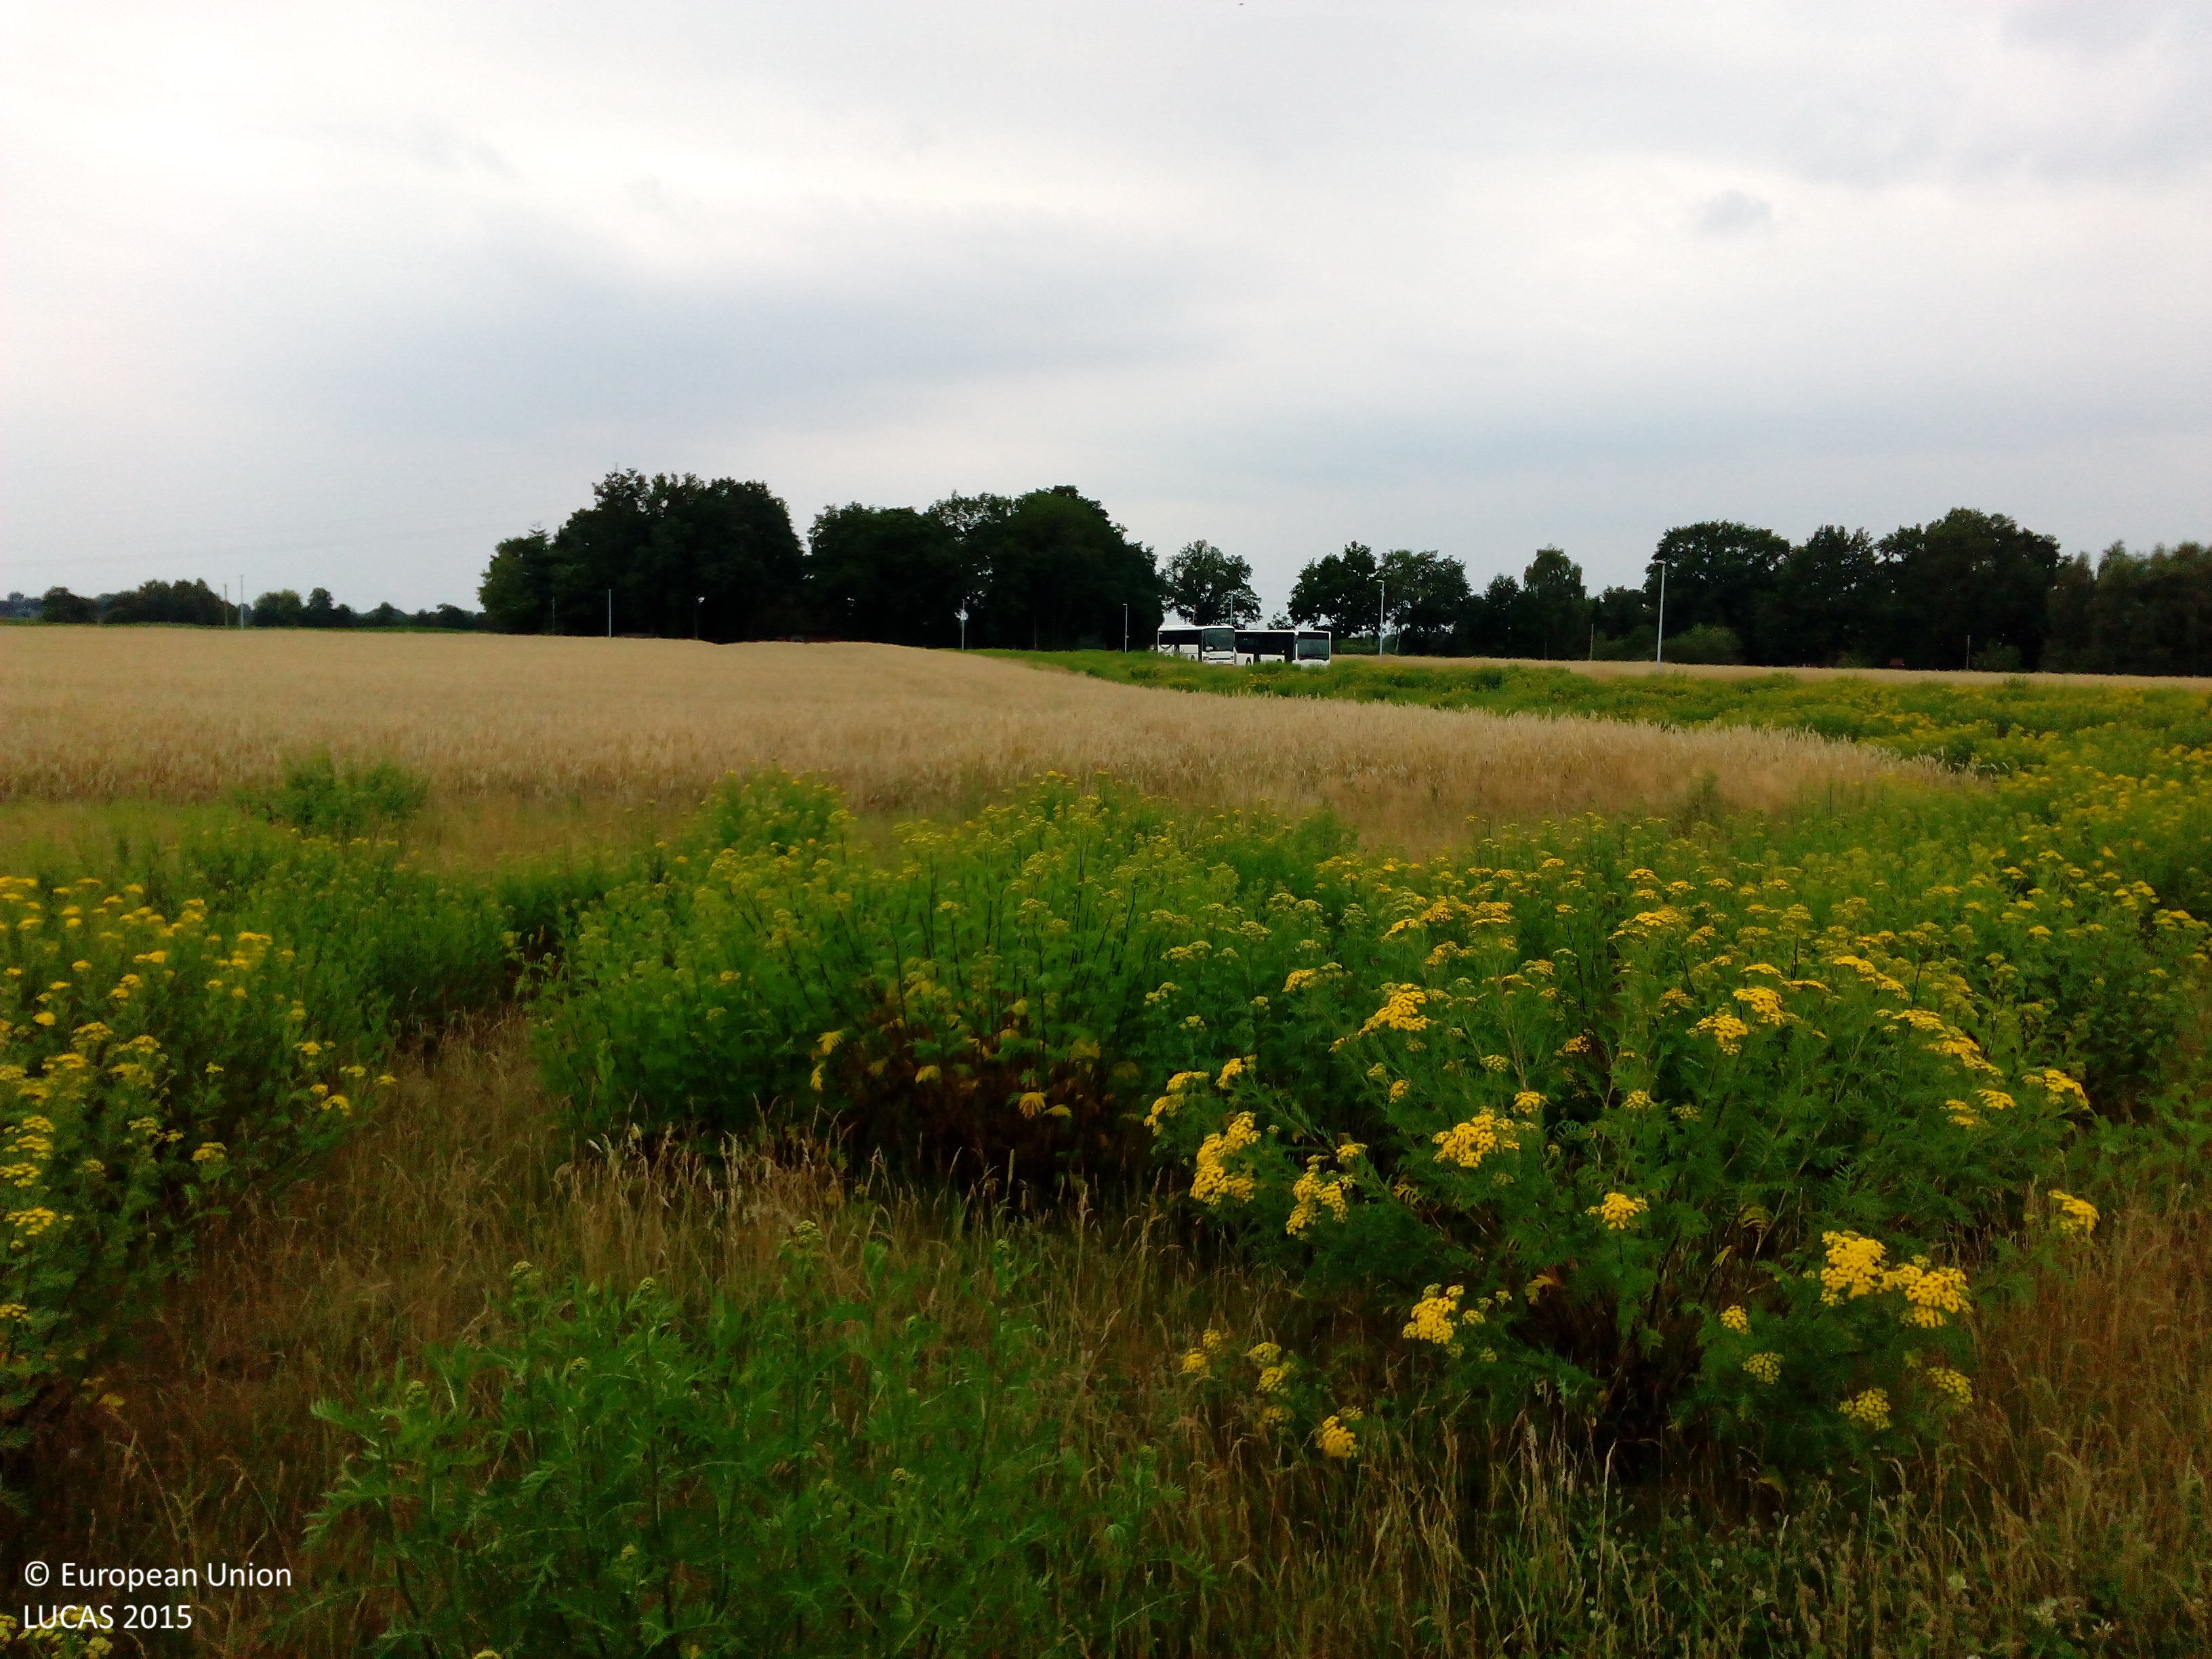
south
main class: Grassland
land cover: Spontaneously vegetated surfaces
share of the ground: > 75 %
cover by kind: herbaceous plants 100 %
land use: Fallow land
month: July
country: DE
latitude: 52.9892
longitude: 7.9597
